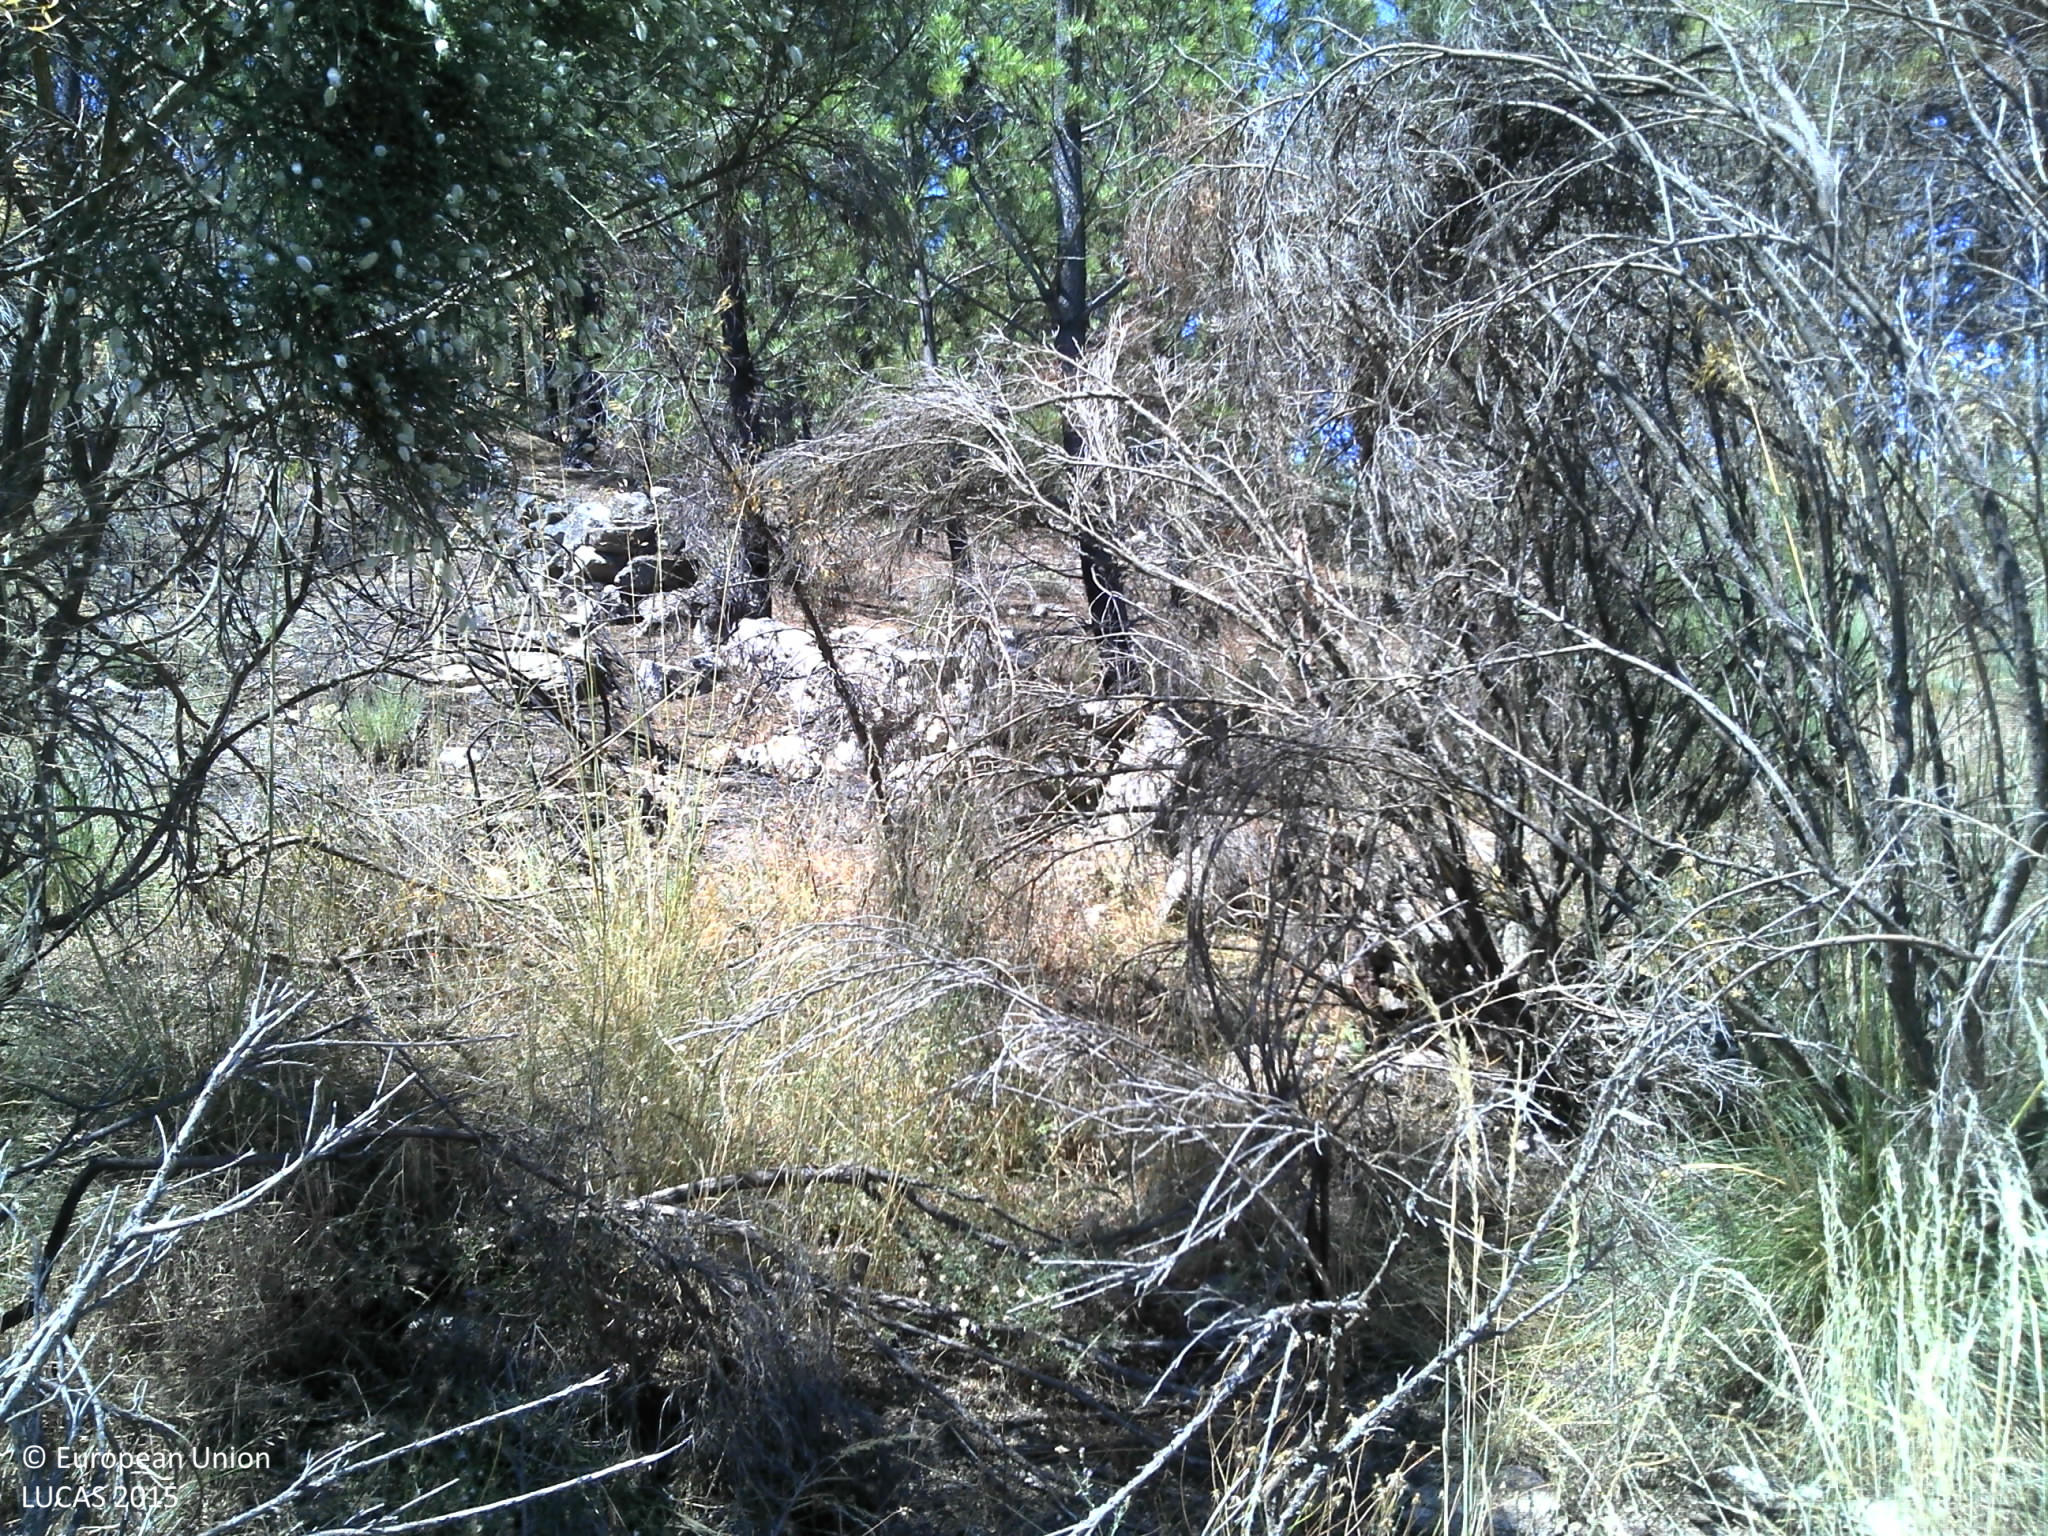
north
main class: Grassland
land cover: Spontaneously vegetated surfaces
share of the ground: 50 - 75 %
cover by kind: herbaceous plants 60 %, unconsolidated bare surface 40 %
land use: Semi-natural and natural areas not in use
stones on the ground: 10 - 25 %
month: June
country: PT
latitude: 40.7350
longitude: -7.3641
